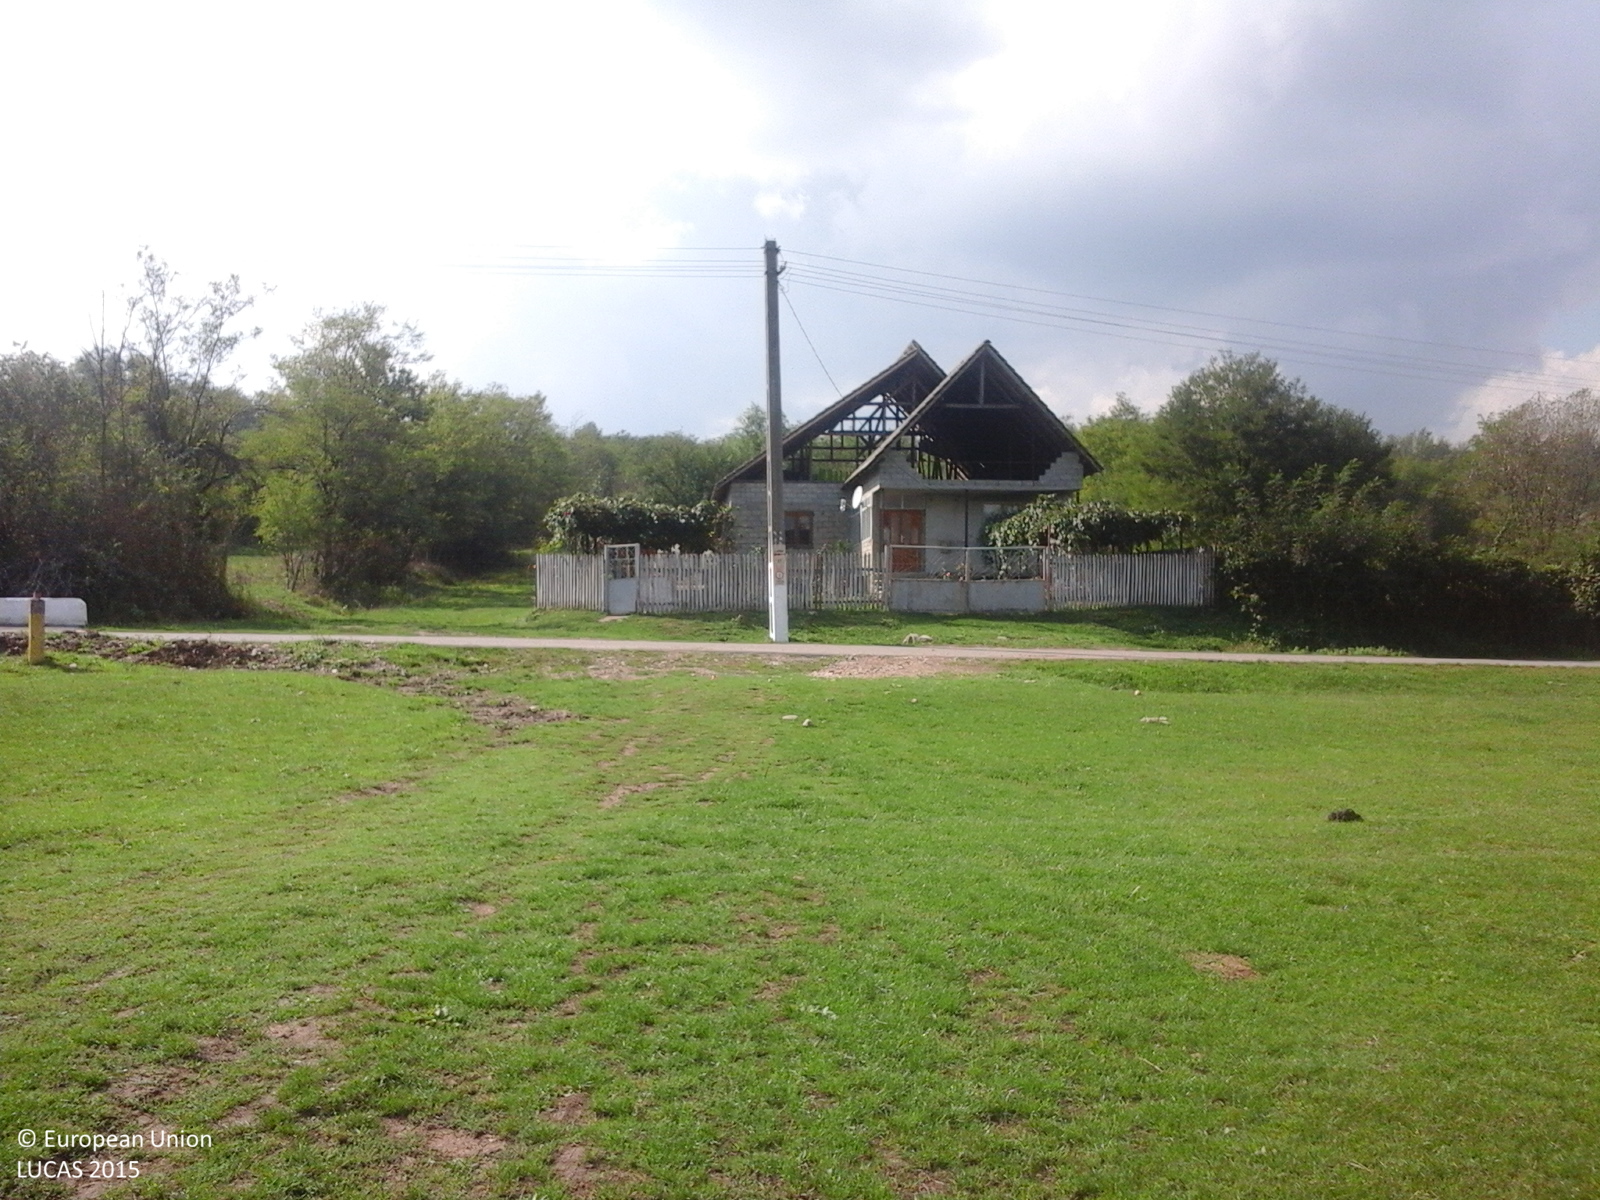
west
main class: Grassland
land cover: Grassland without tree/shrub cover
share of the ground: > 75 %
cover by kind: herbaceous plants 100 %
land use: Agriculture (excluding fallow land and kitchen gardens)
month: September
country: RO
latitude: 45.0126
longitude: 22.9530
